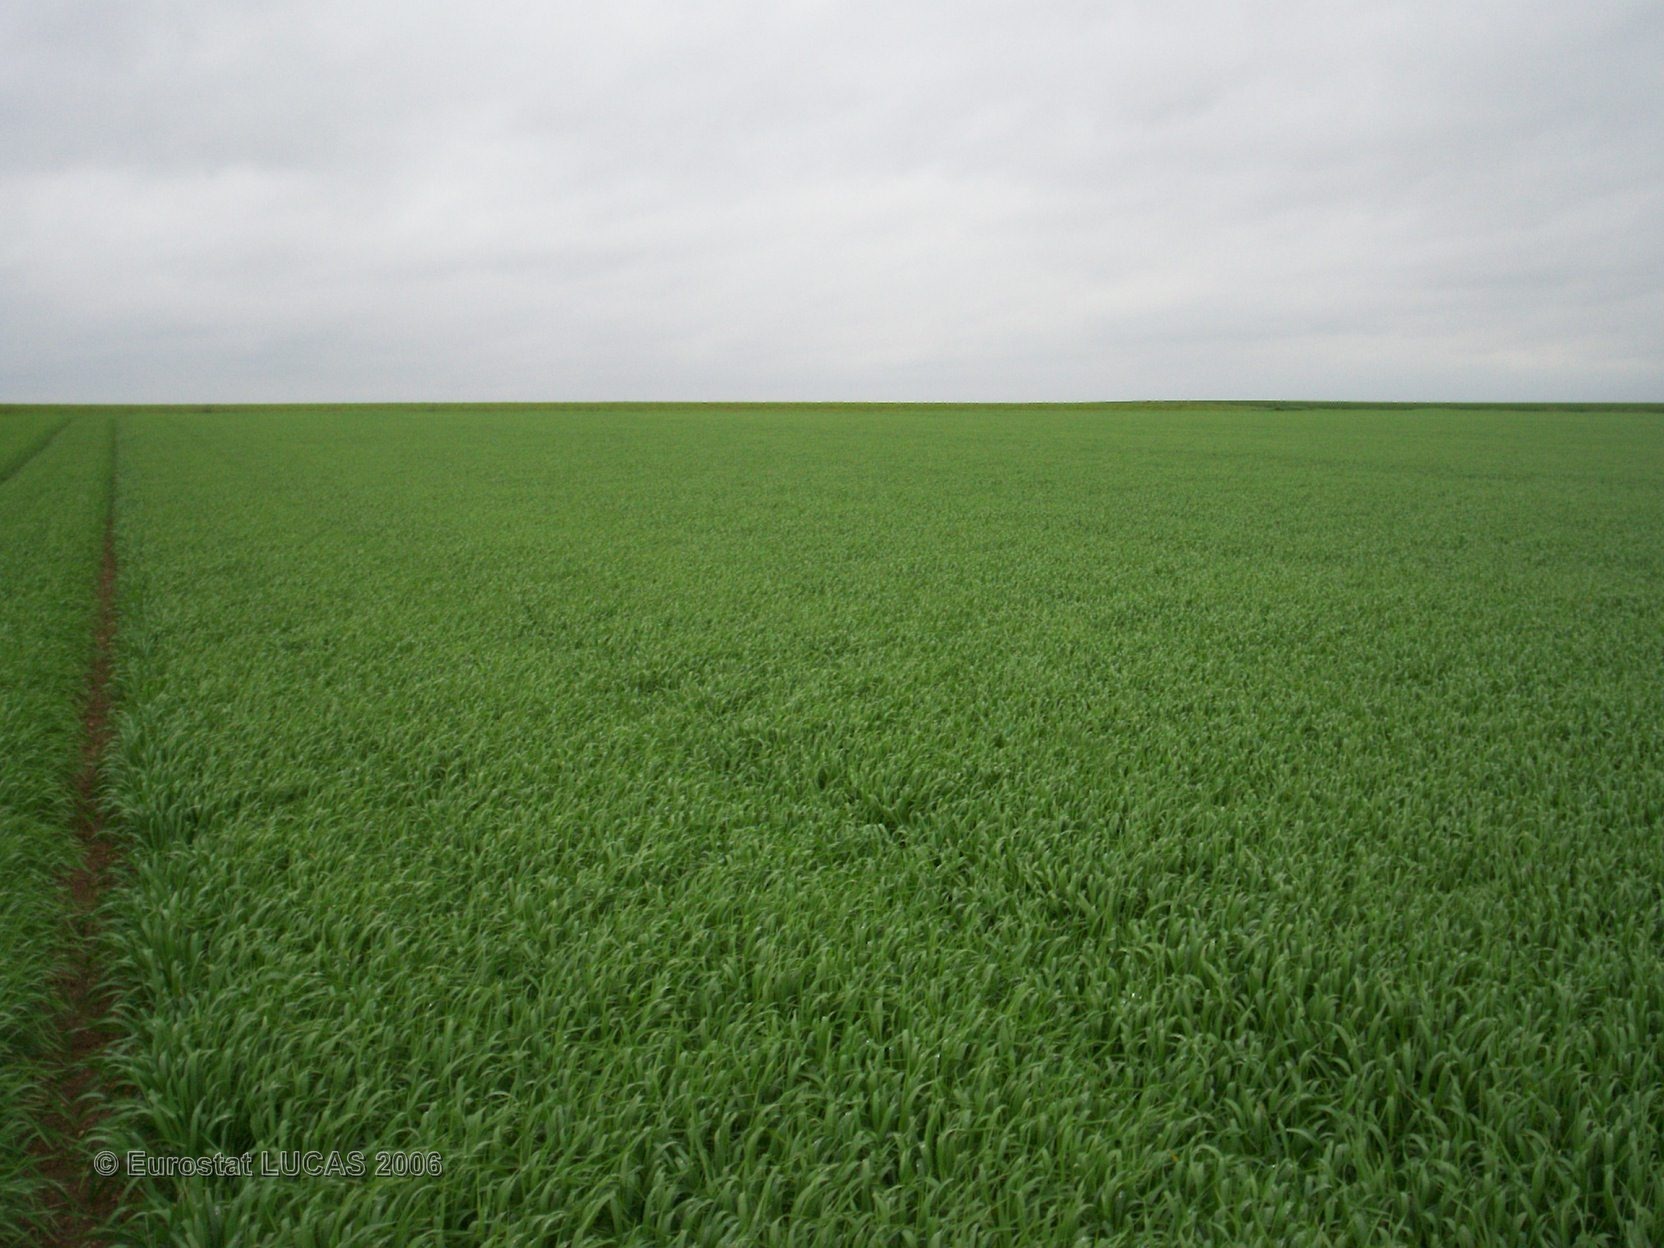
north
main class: Cropland
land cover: Barley
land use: Agriculture (excluding fallow land and kitchen gardens)
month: May
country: FR
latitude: 49.3267
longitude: 4.4236
